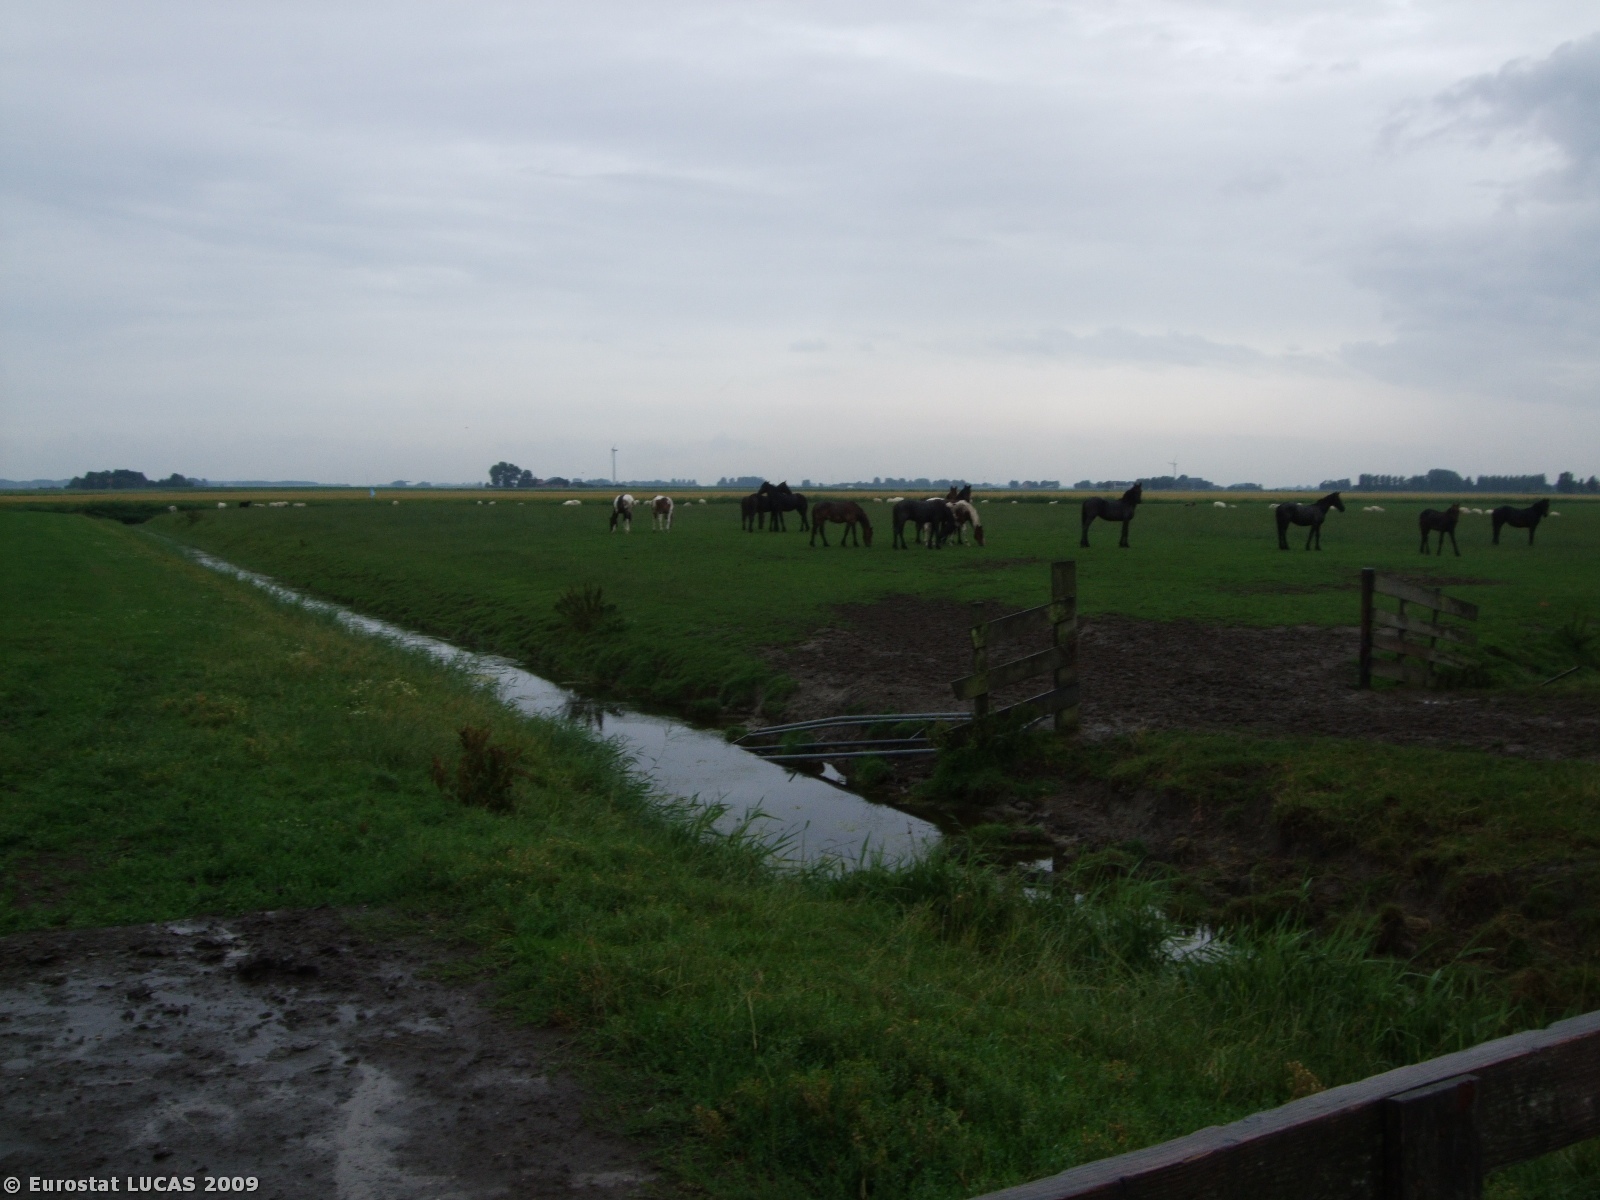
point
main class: Grassland
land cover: Grassland without tree/shrub cover
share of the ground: > 75 %
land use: Agriculture (excluding fallow land and kitchen gardens)
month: July
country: NL
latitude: 53.2144
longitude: 5.6113
